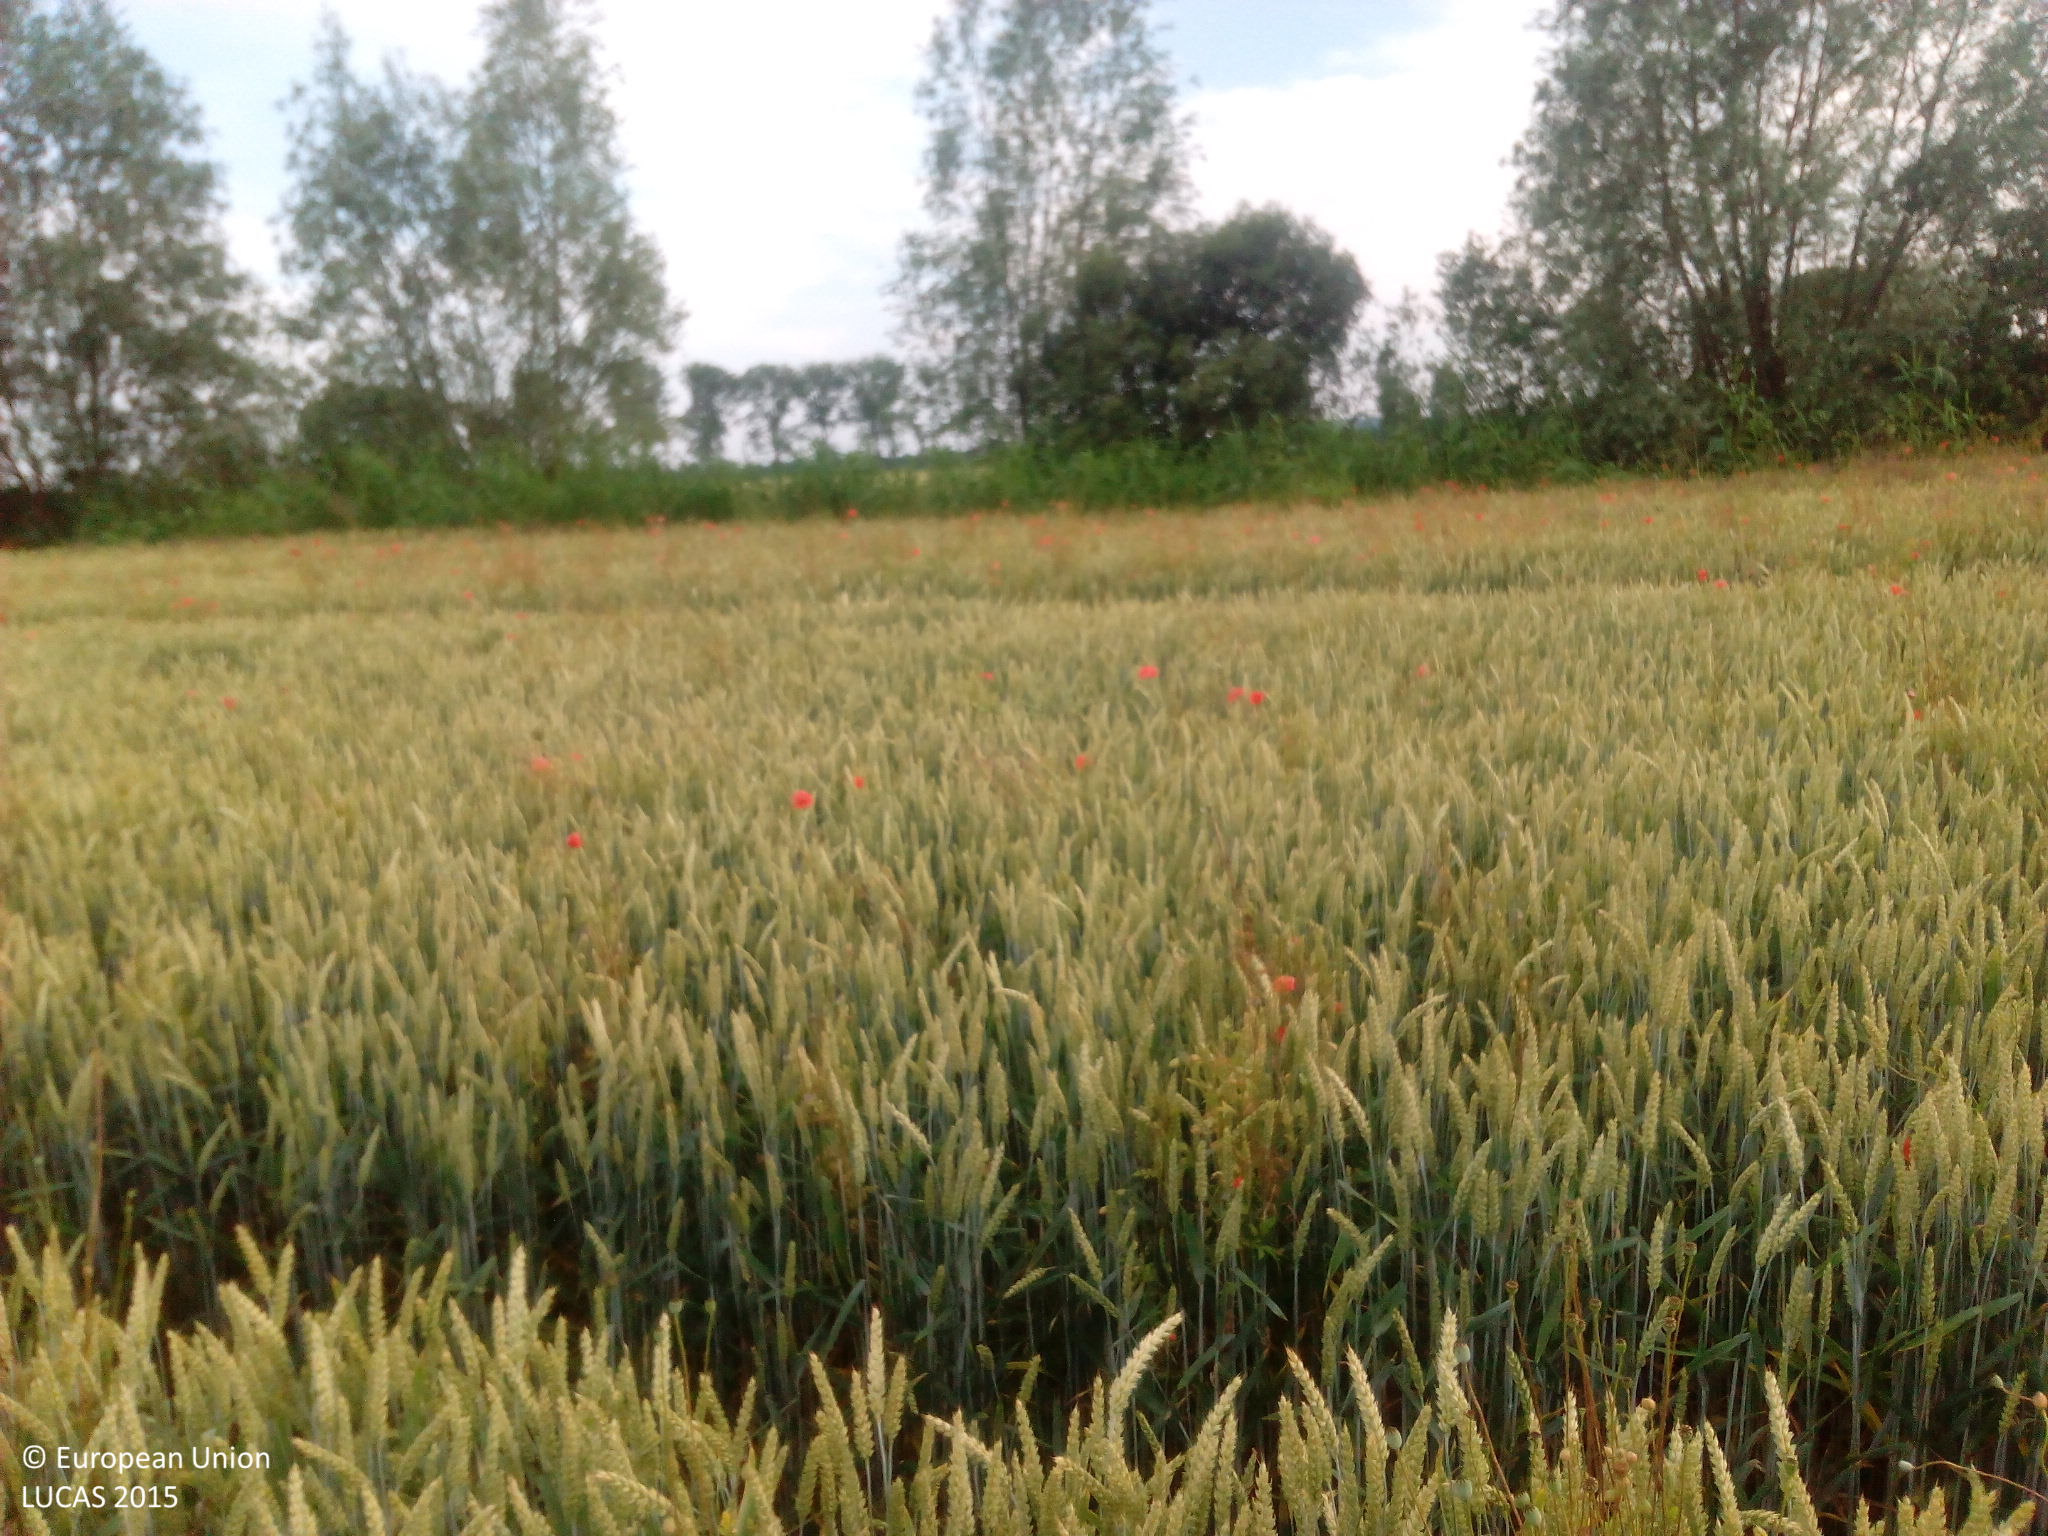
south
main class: Cropland
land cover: Common wheat
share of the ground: > 75 %
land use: Agriculture (excluding fallow land and kitchen gardens)
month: July
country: DE
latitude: 52.8024
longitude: 12.4173
